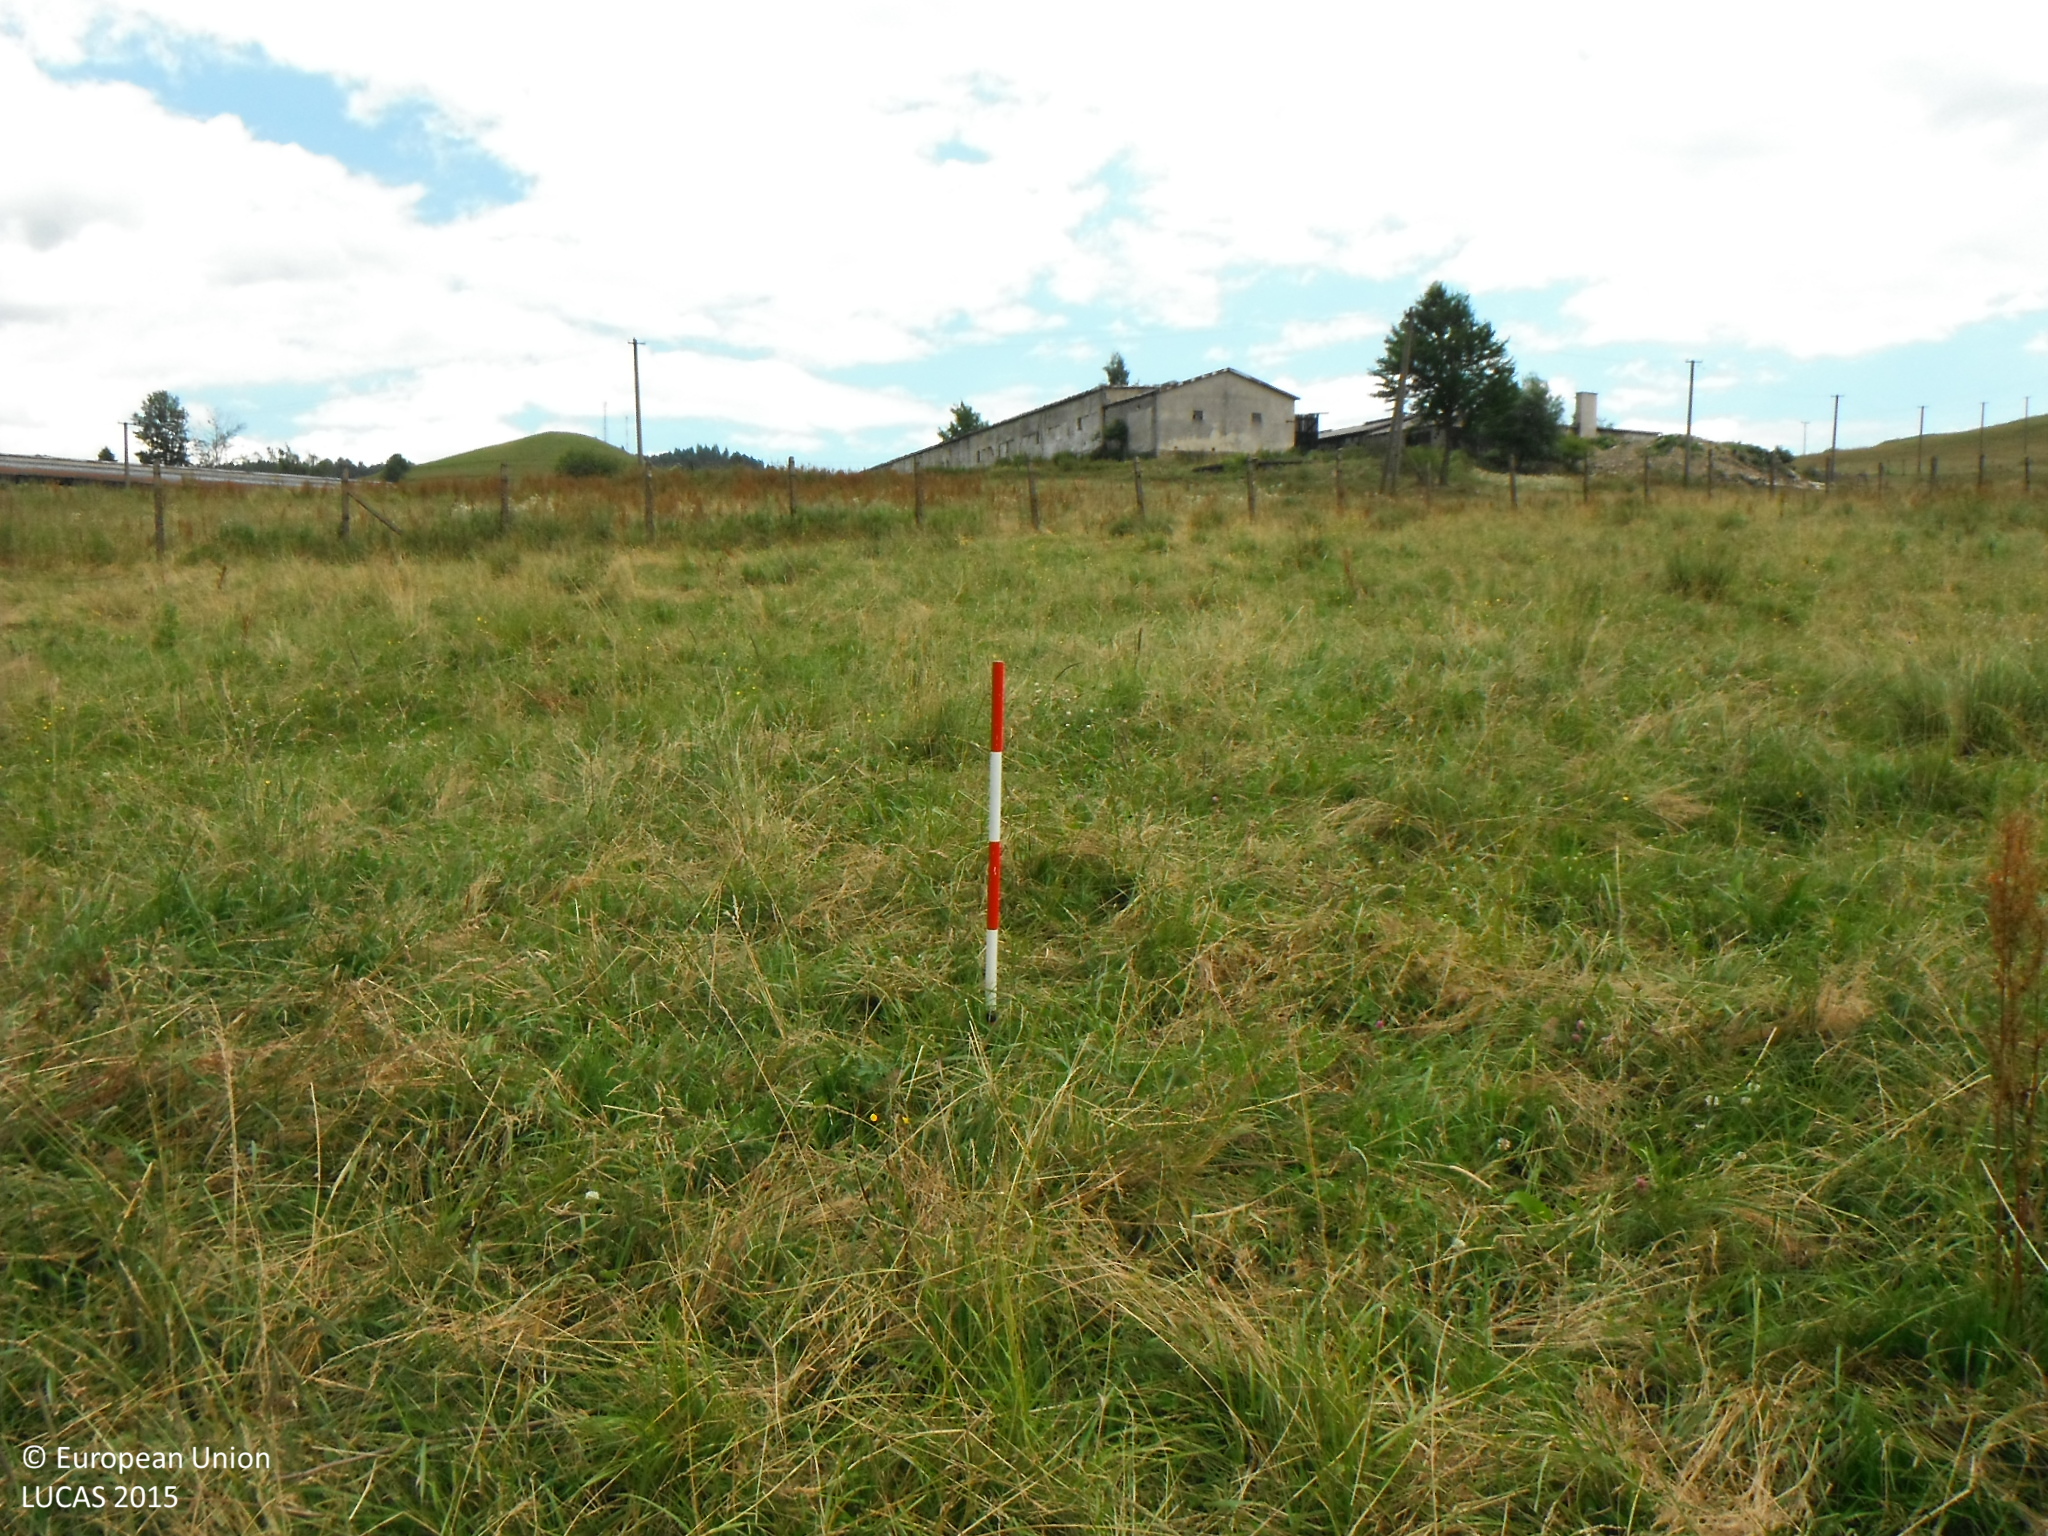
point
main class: Grassland
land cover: Grassland without tree/shrub cover
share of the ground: > 75 %
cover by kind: herbaceous plants 100 %
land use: Agriculture (excluding fallow land and kitchen gardens)
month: July
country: SK
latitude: 49.2215
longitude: 20.9294
